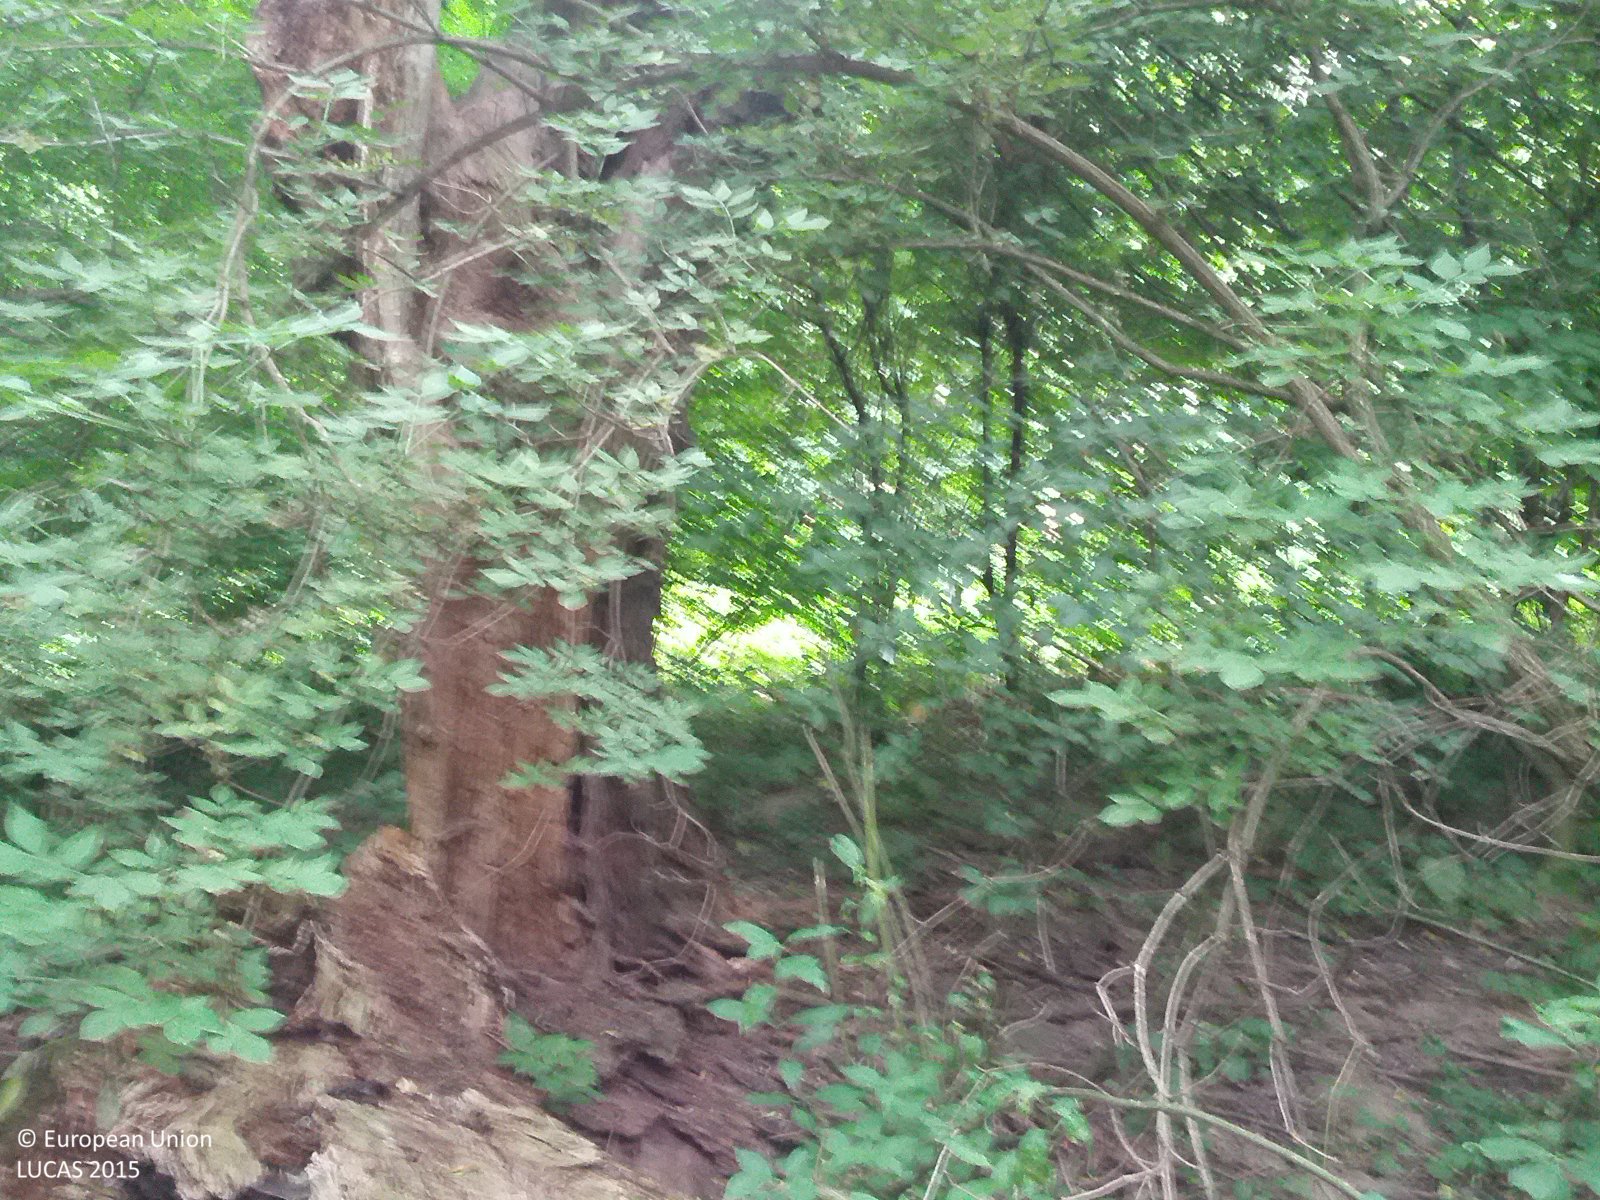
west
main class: Woodland
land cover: Broadleaved woodland
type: floodplain forest
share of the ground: > 75 %
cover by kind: broadleaved forest trees 75 %, shrubs 15 %, herbaceous plants 10 %
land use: Semi-natural and natural areas not in use
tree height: > 5 m
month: July
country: AT
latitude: 48.7655
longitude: 16.6053
